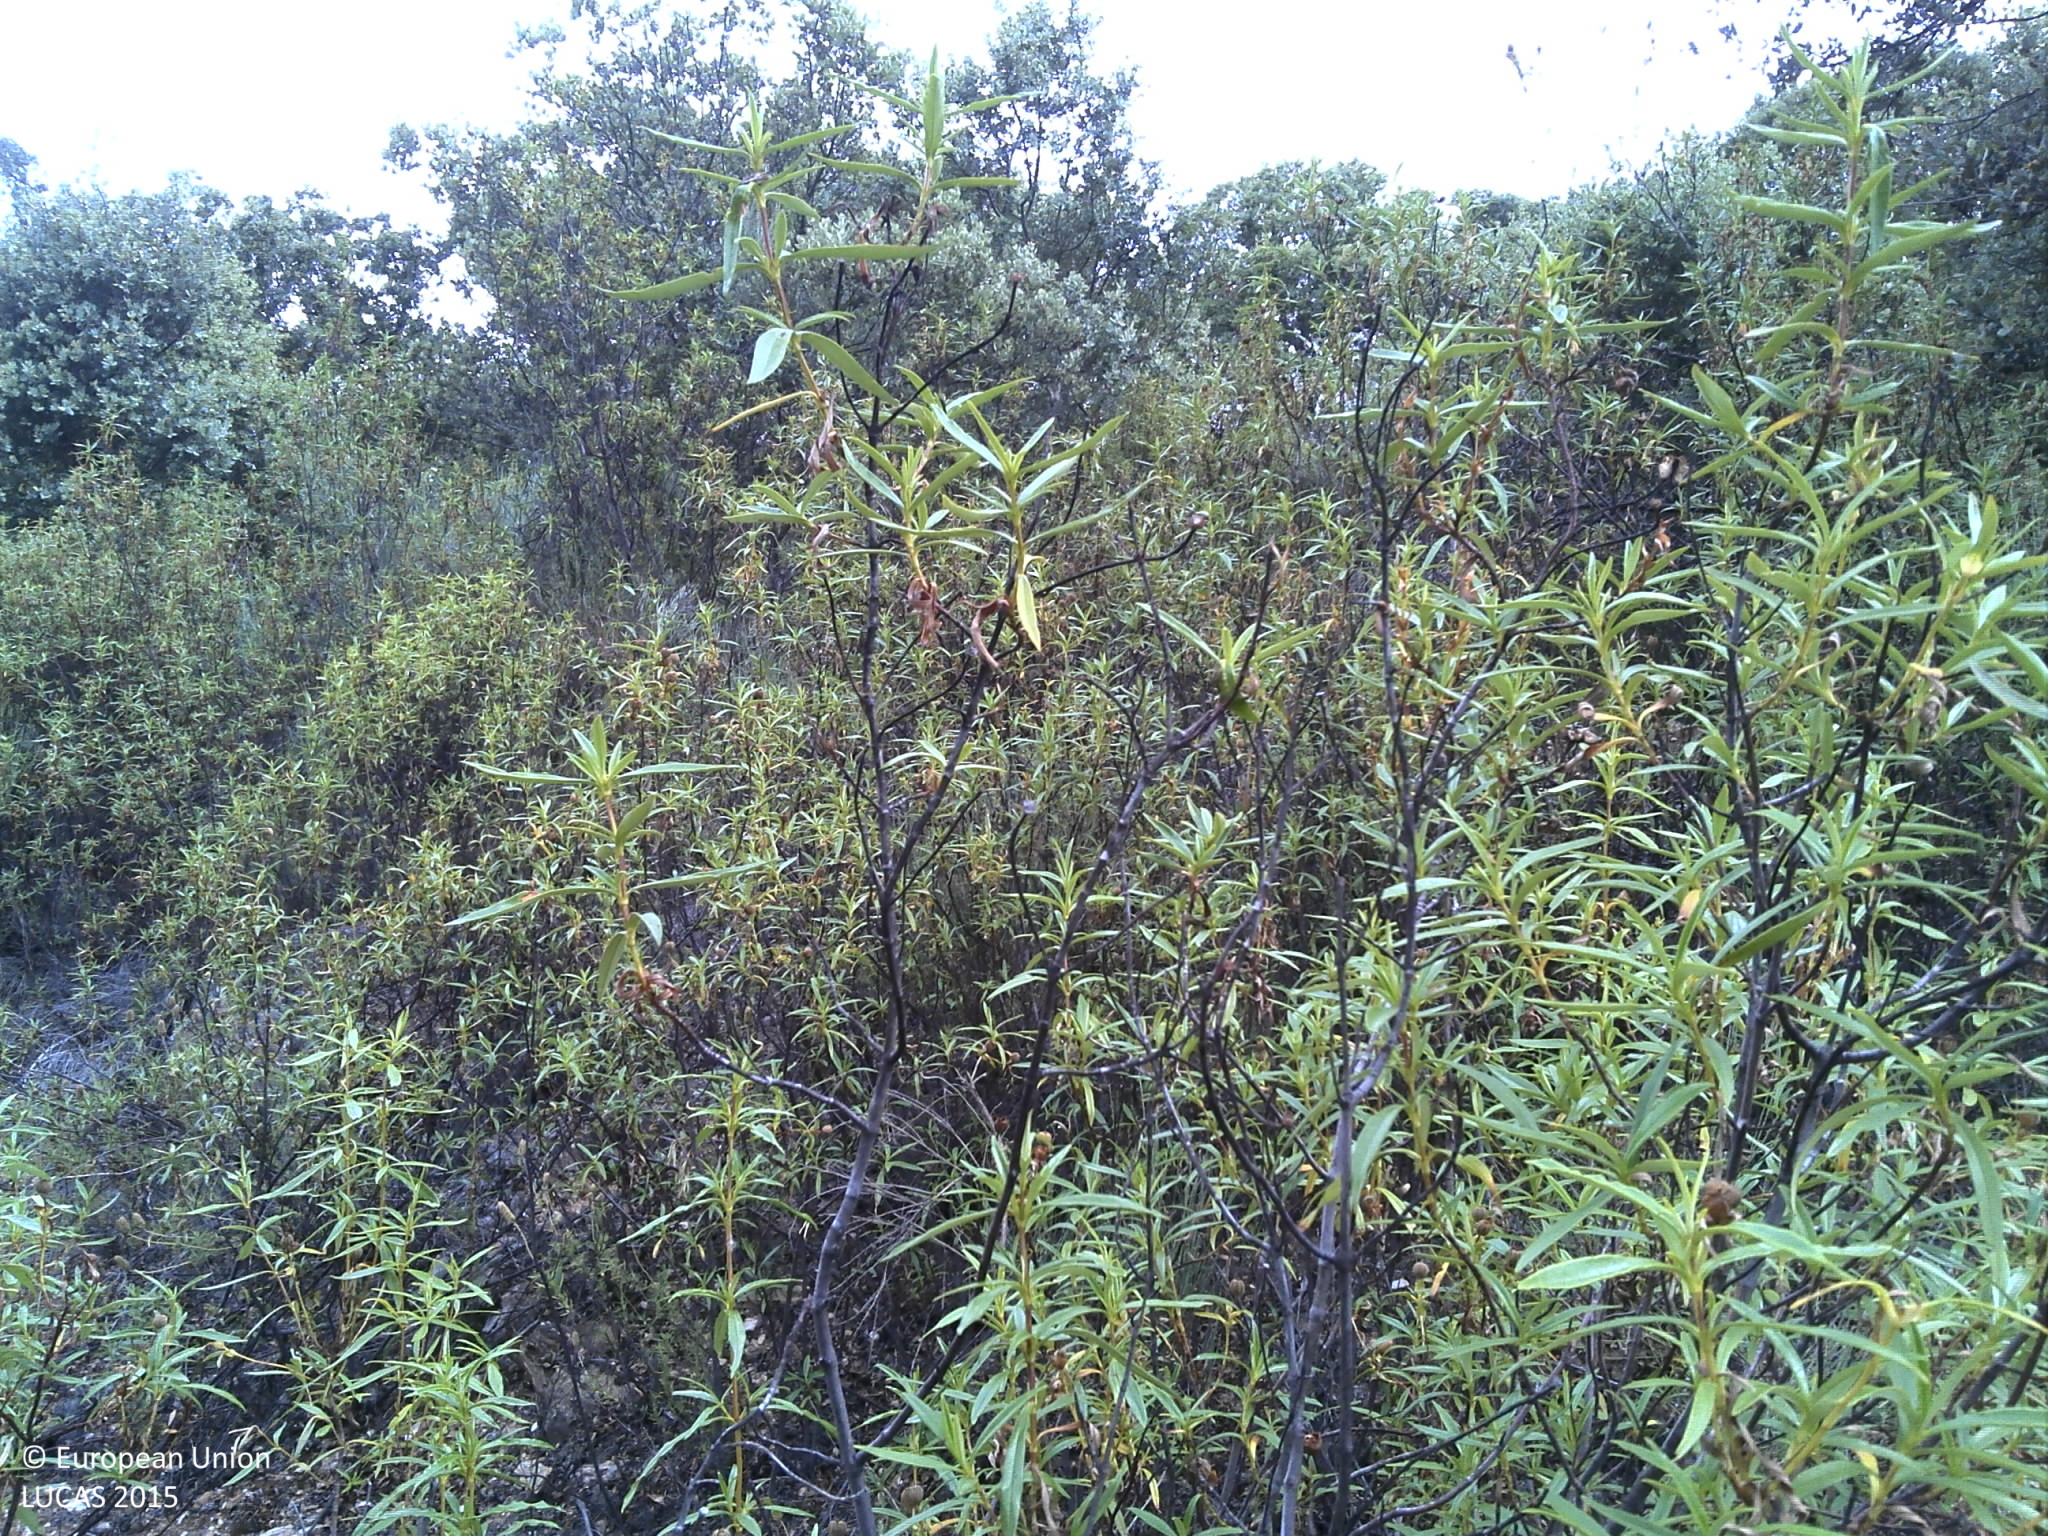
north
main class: Woodland
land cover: Broadleaved woodland
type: broadleaved evergreen forest
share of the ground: 10 - 25 %
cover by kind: shrubs 70 %, unconsolidated bare surface 20 %, broadleaved forest trees 10 %
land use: Semi-natural and natural areas not in use
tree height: > 5 m
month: June
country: PT
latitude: 41.3854
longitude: -6.9123
